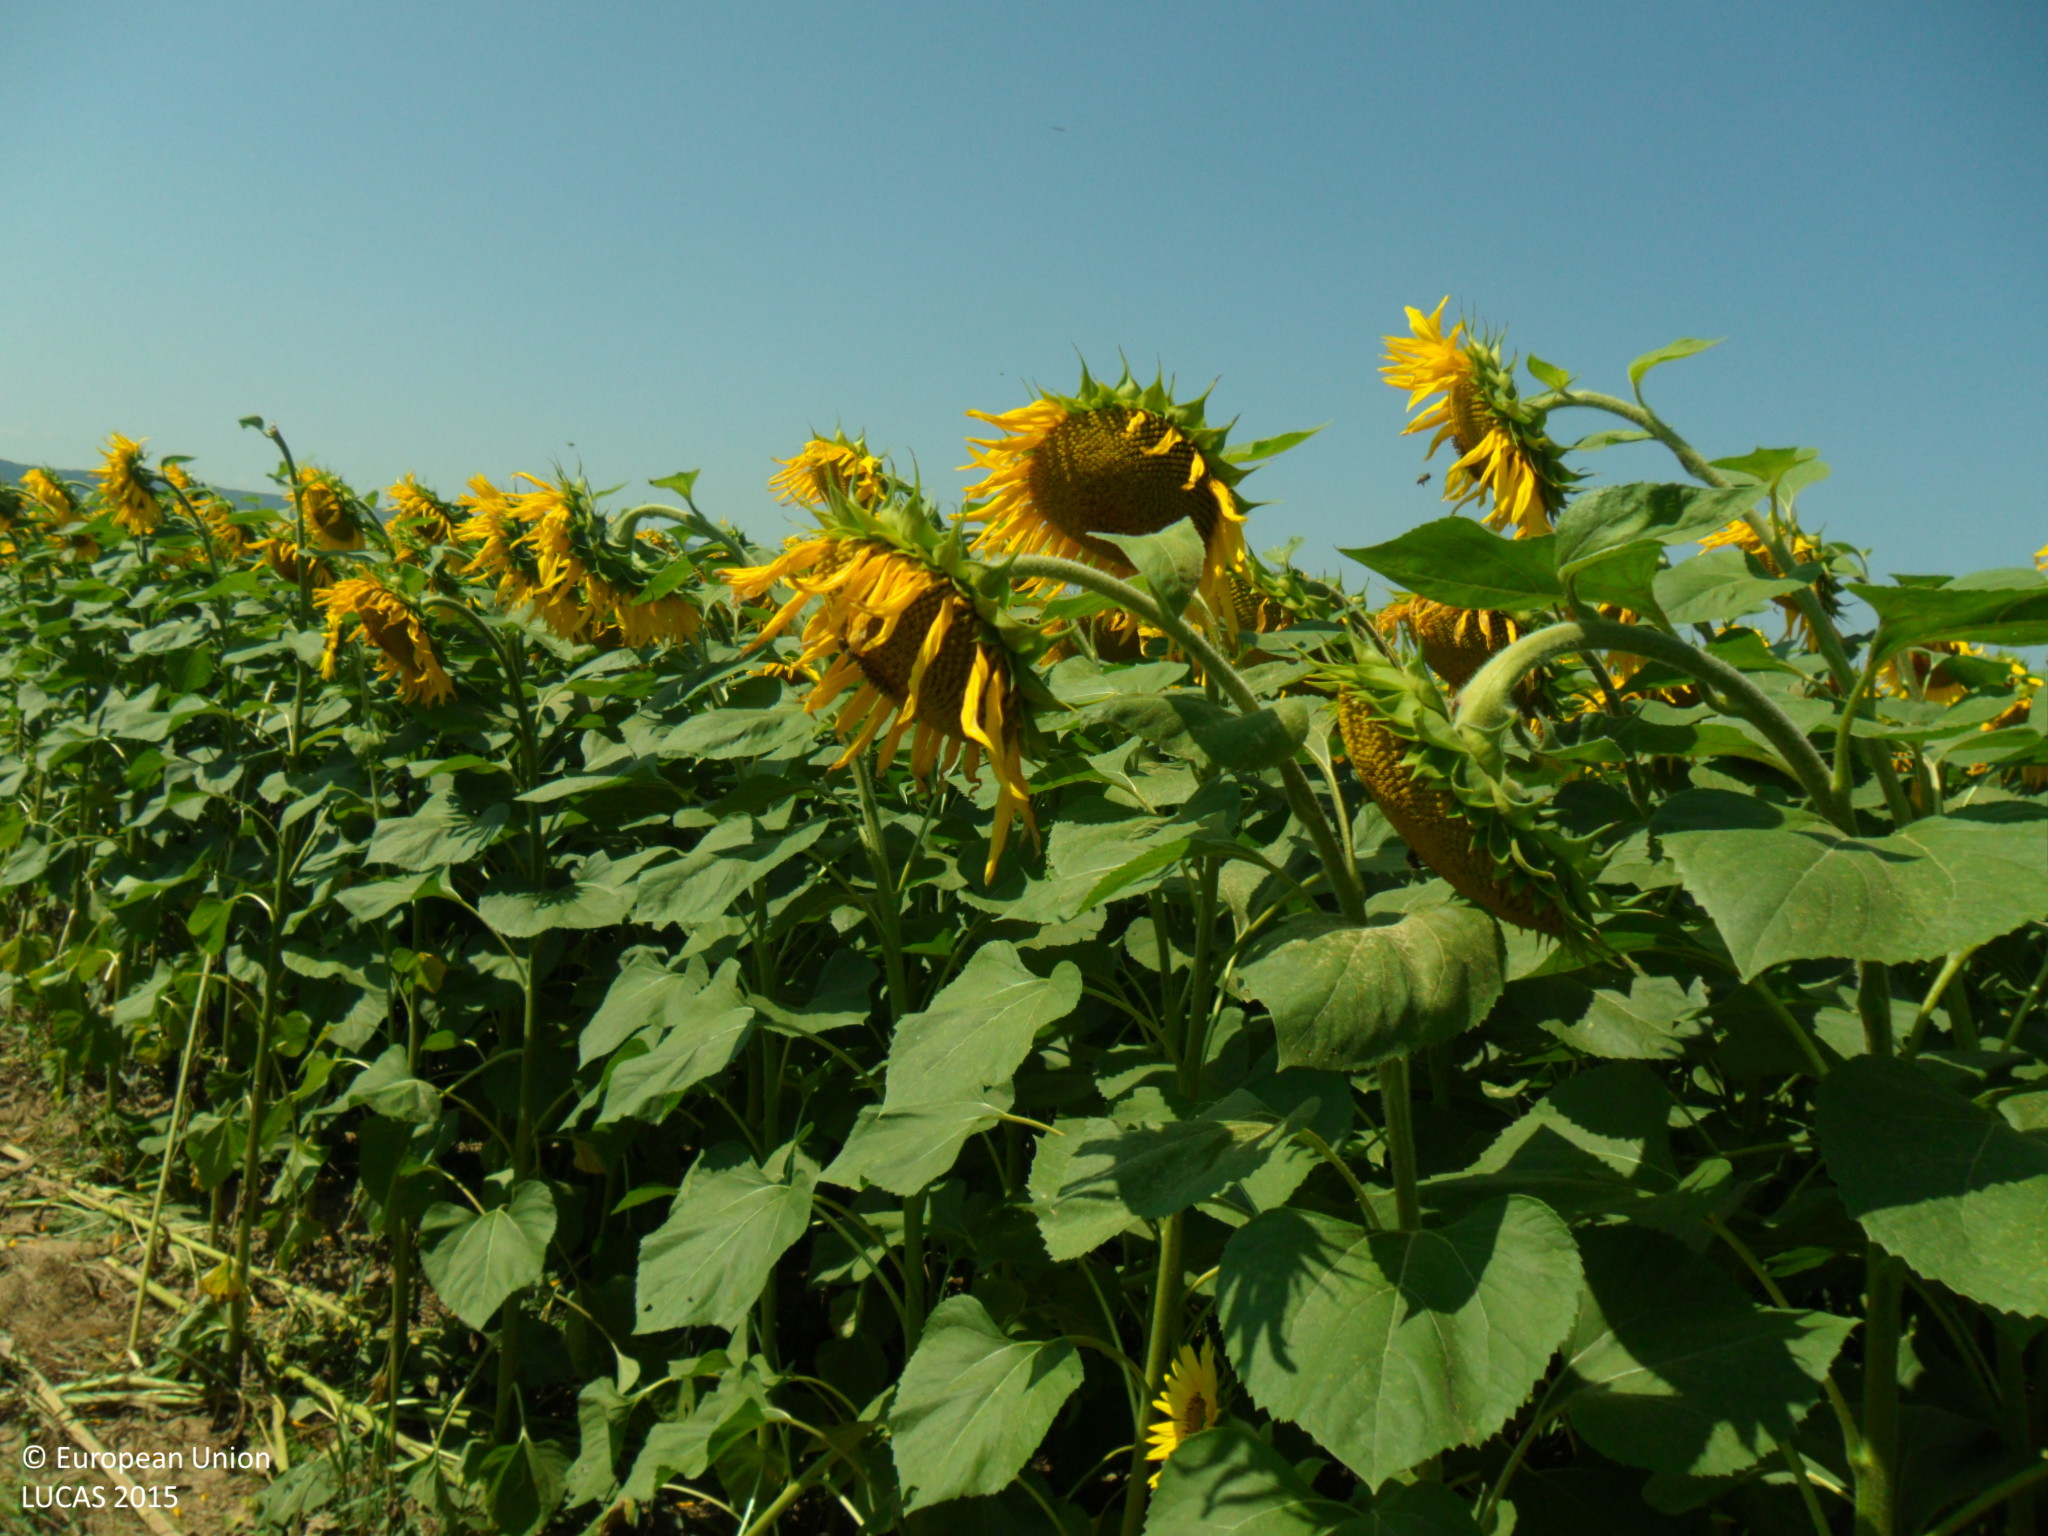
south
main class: Cropland
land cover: Sunflower
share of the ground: > 75 %
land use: Agriculture (excluding fallow land and kitchen gardens)
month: July
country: BG
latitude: 43.0956
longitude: 27.0307
